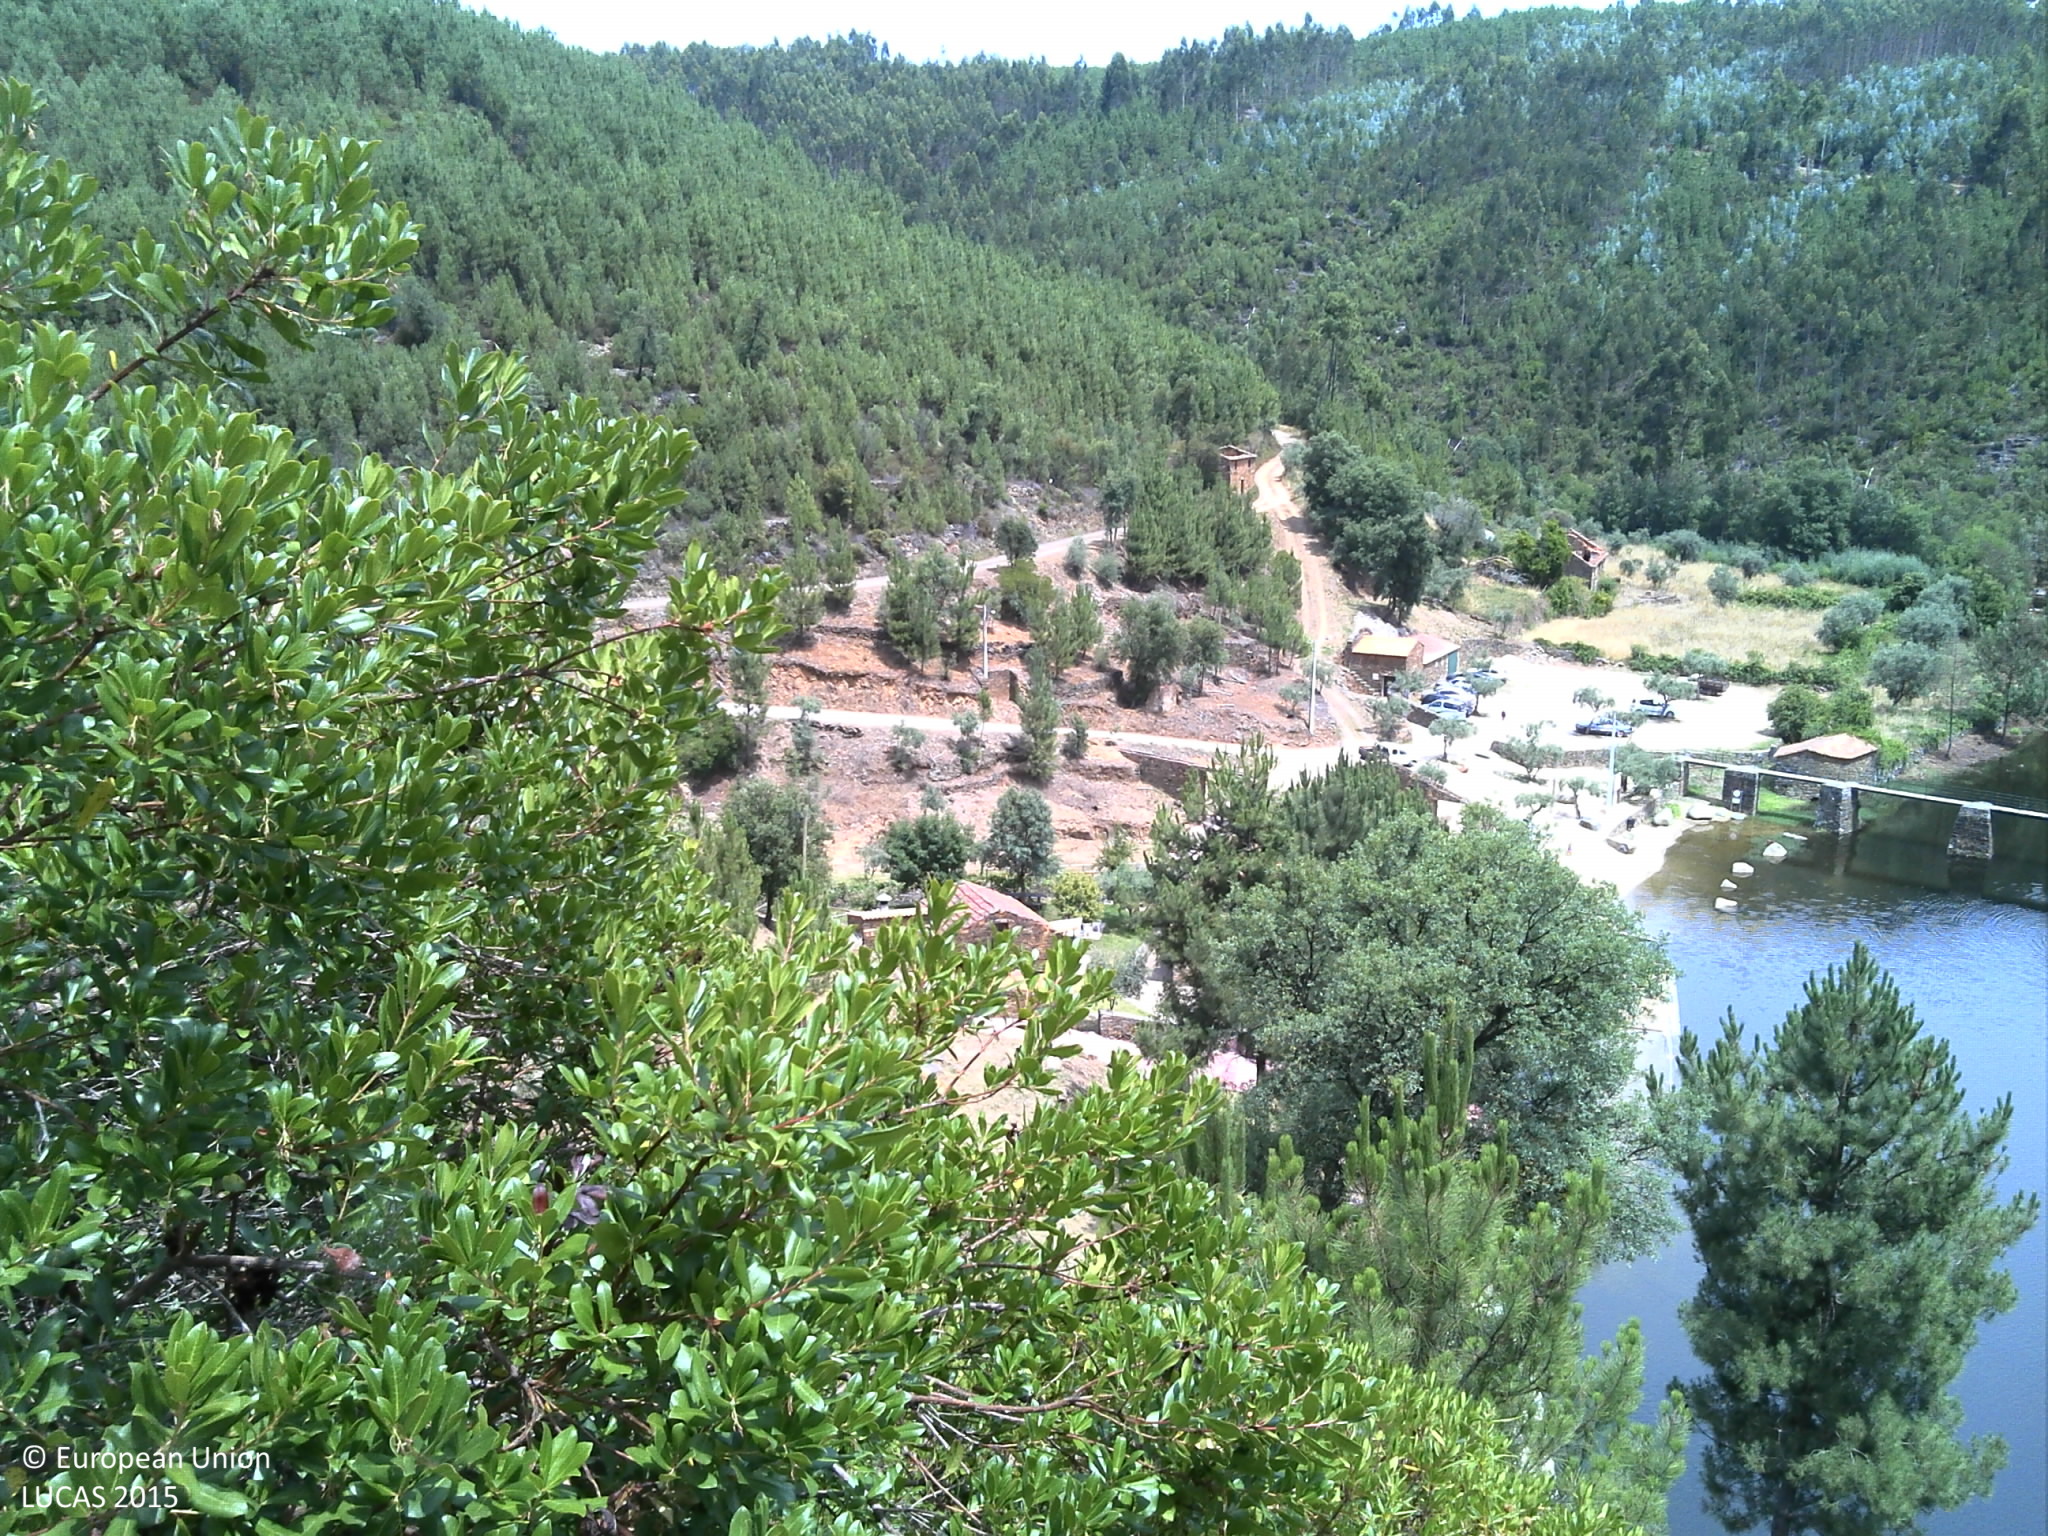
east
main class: Shrubland
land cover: Shrubland with sparse tree cover
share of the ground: 25 - 50 %
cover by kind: shrubs 35 %, consolidated bare surface 30 %, unconsolidated bare surface 30 %, broadleaved forest trees 5 %
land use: Semi-natural and natural areas not in use
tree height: < 5 m
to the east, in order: Shrubland with sparse tree cover; Artificial constructions in urban areas; Shrubland with sparse tree cover; Dry stone walls; Shrubland with sparse tree cover; Tracks; Electric lines; Dry stone walls; Shrubland with sparse tree cover; Dry stone walls; Pine dominated coniferous woodland; Tracks; Pine dominated mixed woodland
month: July
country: PT
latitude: 39.8604
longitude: -8.0094
